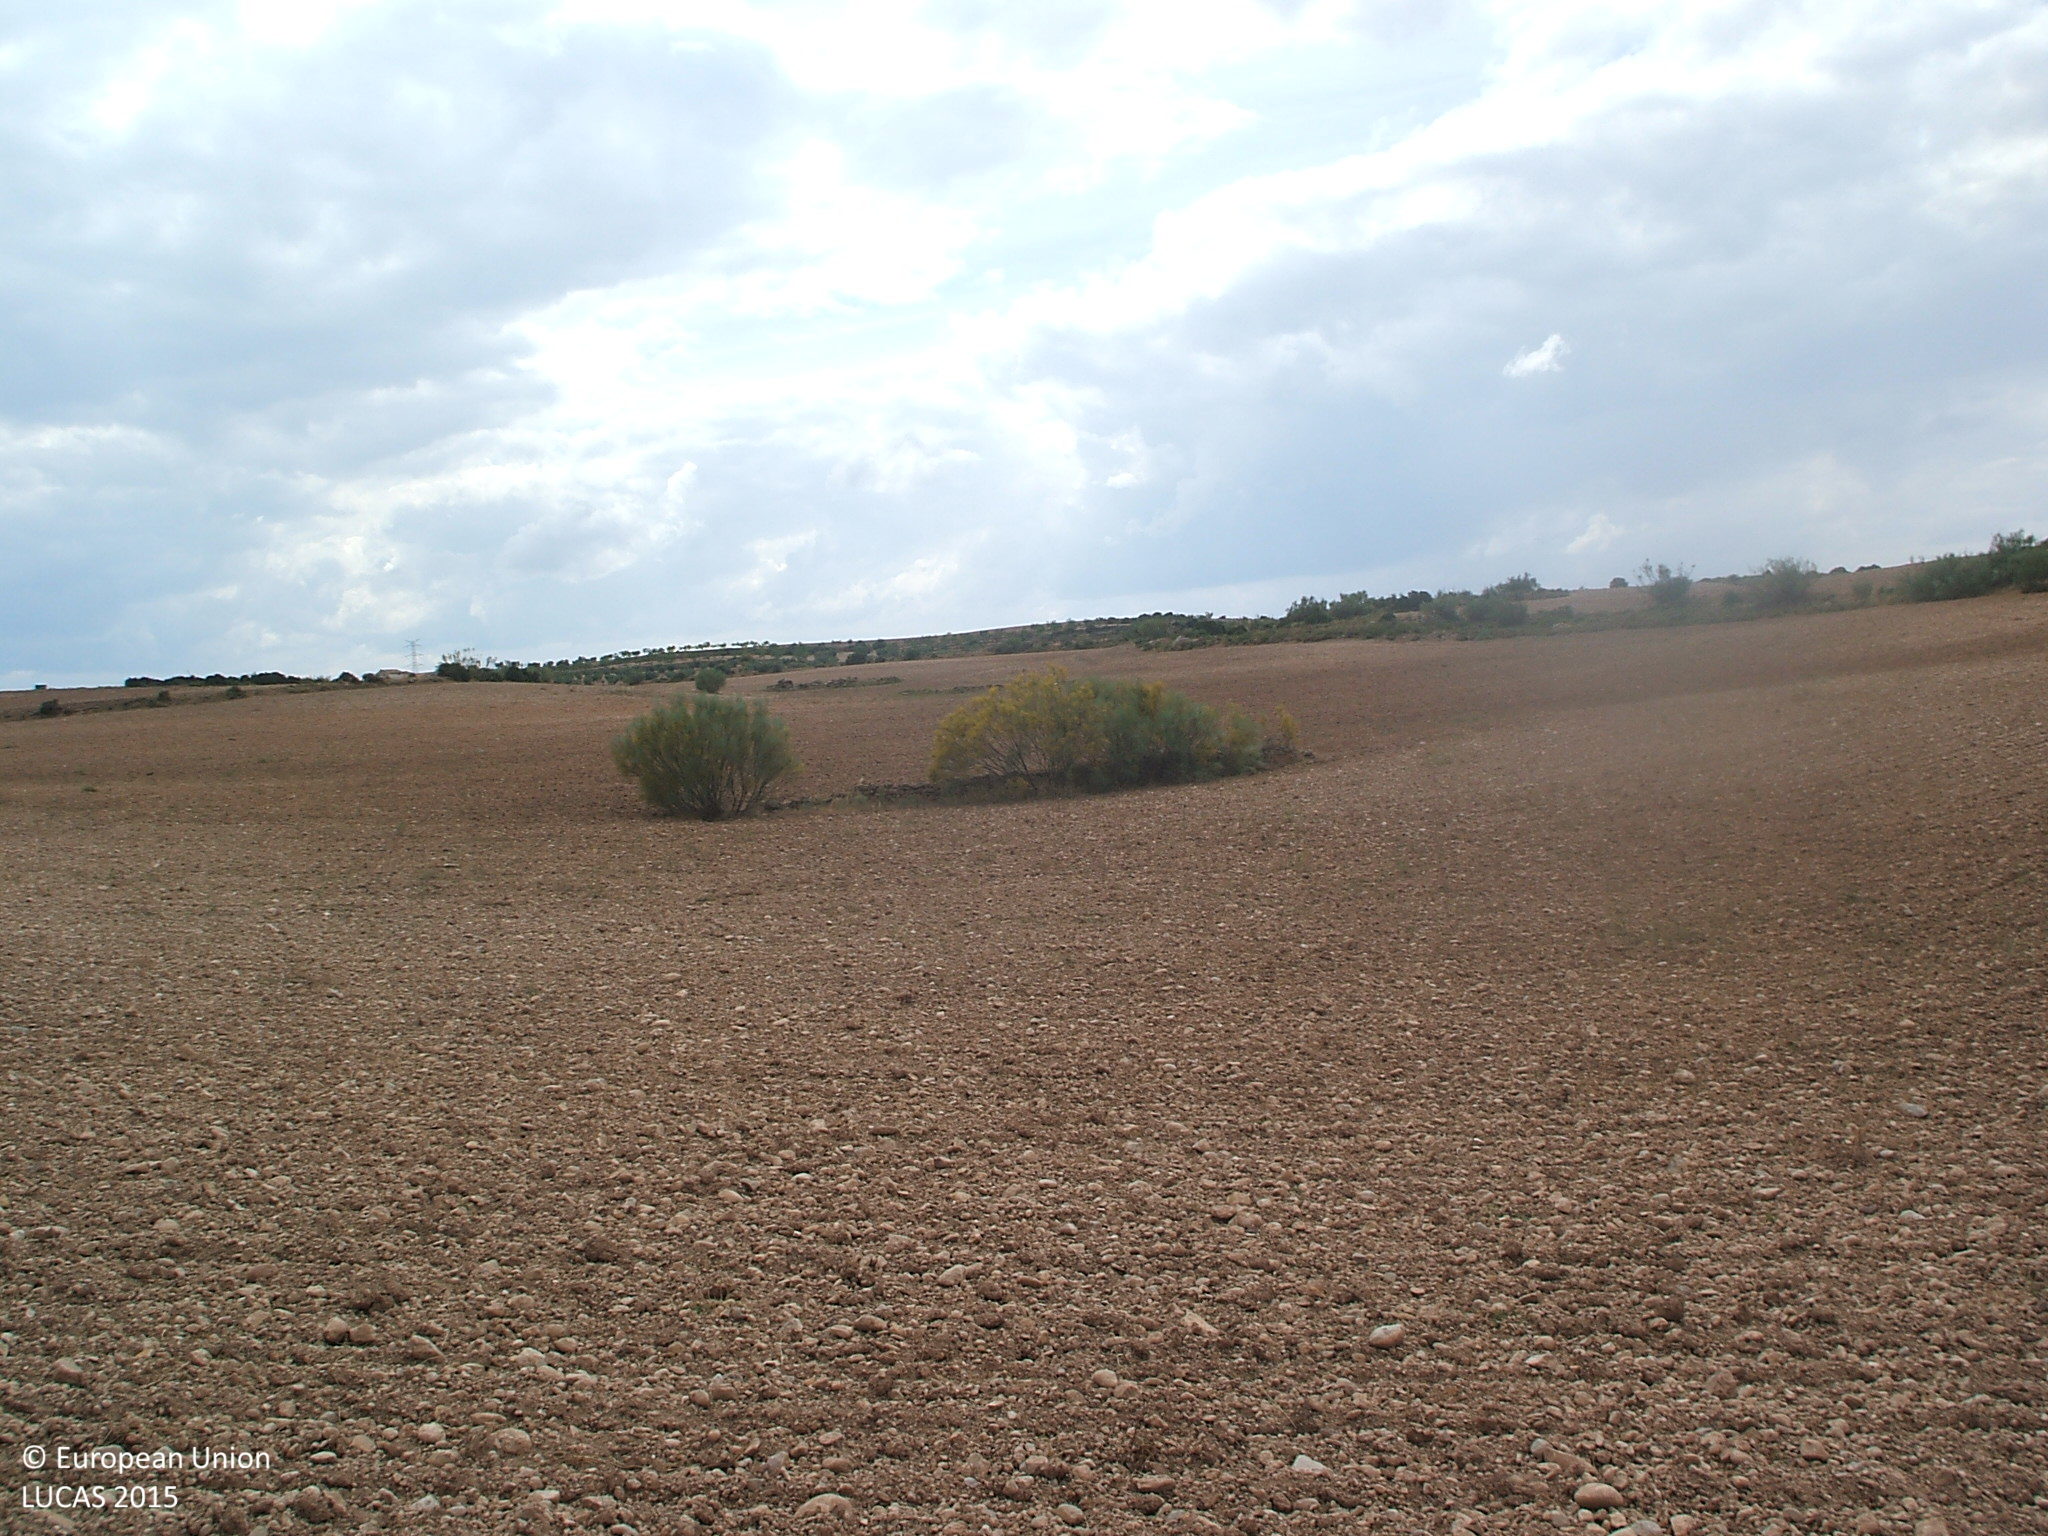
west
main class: Shrubland
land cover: Shrubland with sparse tree cover
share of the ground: > 75 %
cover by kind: shrubs 95 %, coniferous forest trees 5 %
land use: Semi-natural and natural areas not in use
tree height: > 5 m
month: June
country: ES
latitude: 41.0305
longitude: -0.3483
